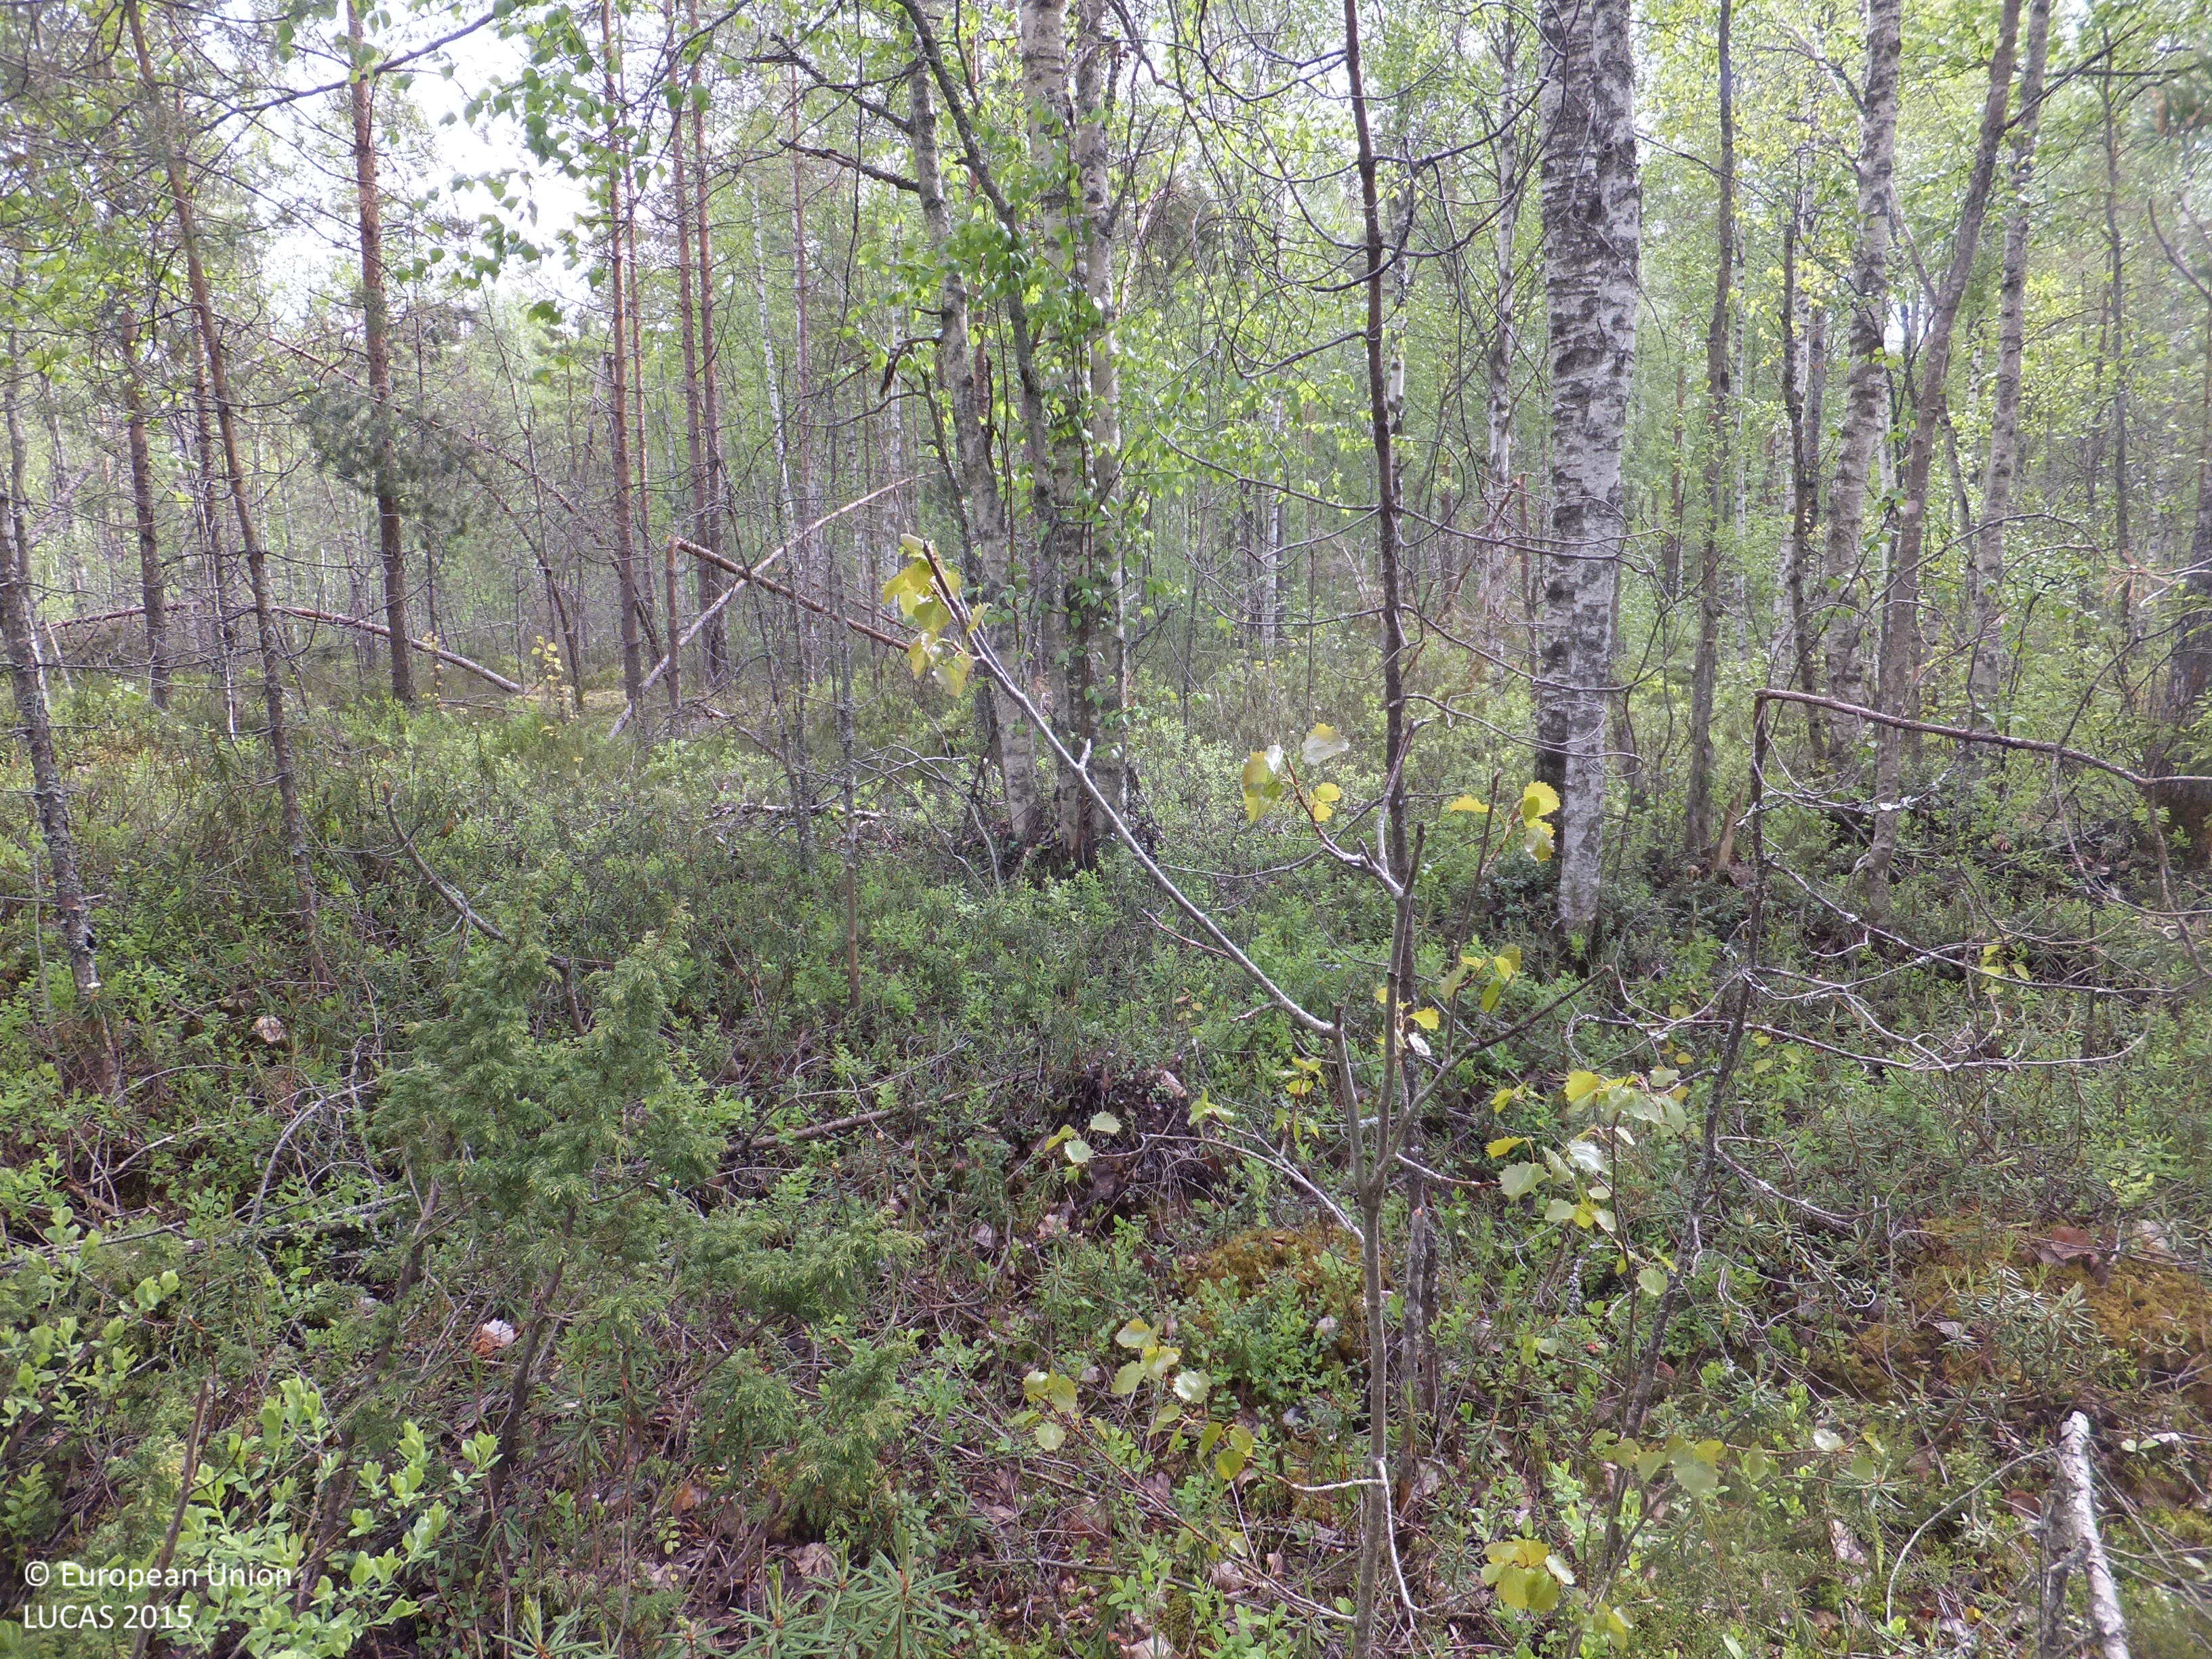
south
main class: Woodland
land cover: Pine dominated mixed woodland
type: boreal forest
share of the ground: 50 - 75 %
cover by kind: broadleaved forest trees 40 %, coniferous forest trees 30 %, shrubs 15 %, lichens and mosses 15 %
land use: Forestry
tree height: > 5 m
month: June
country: FI
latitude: 63.6149
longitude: 23.9240
